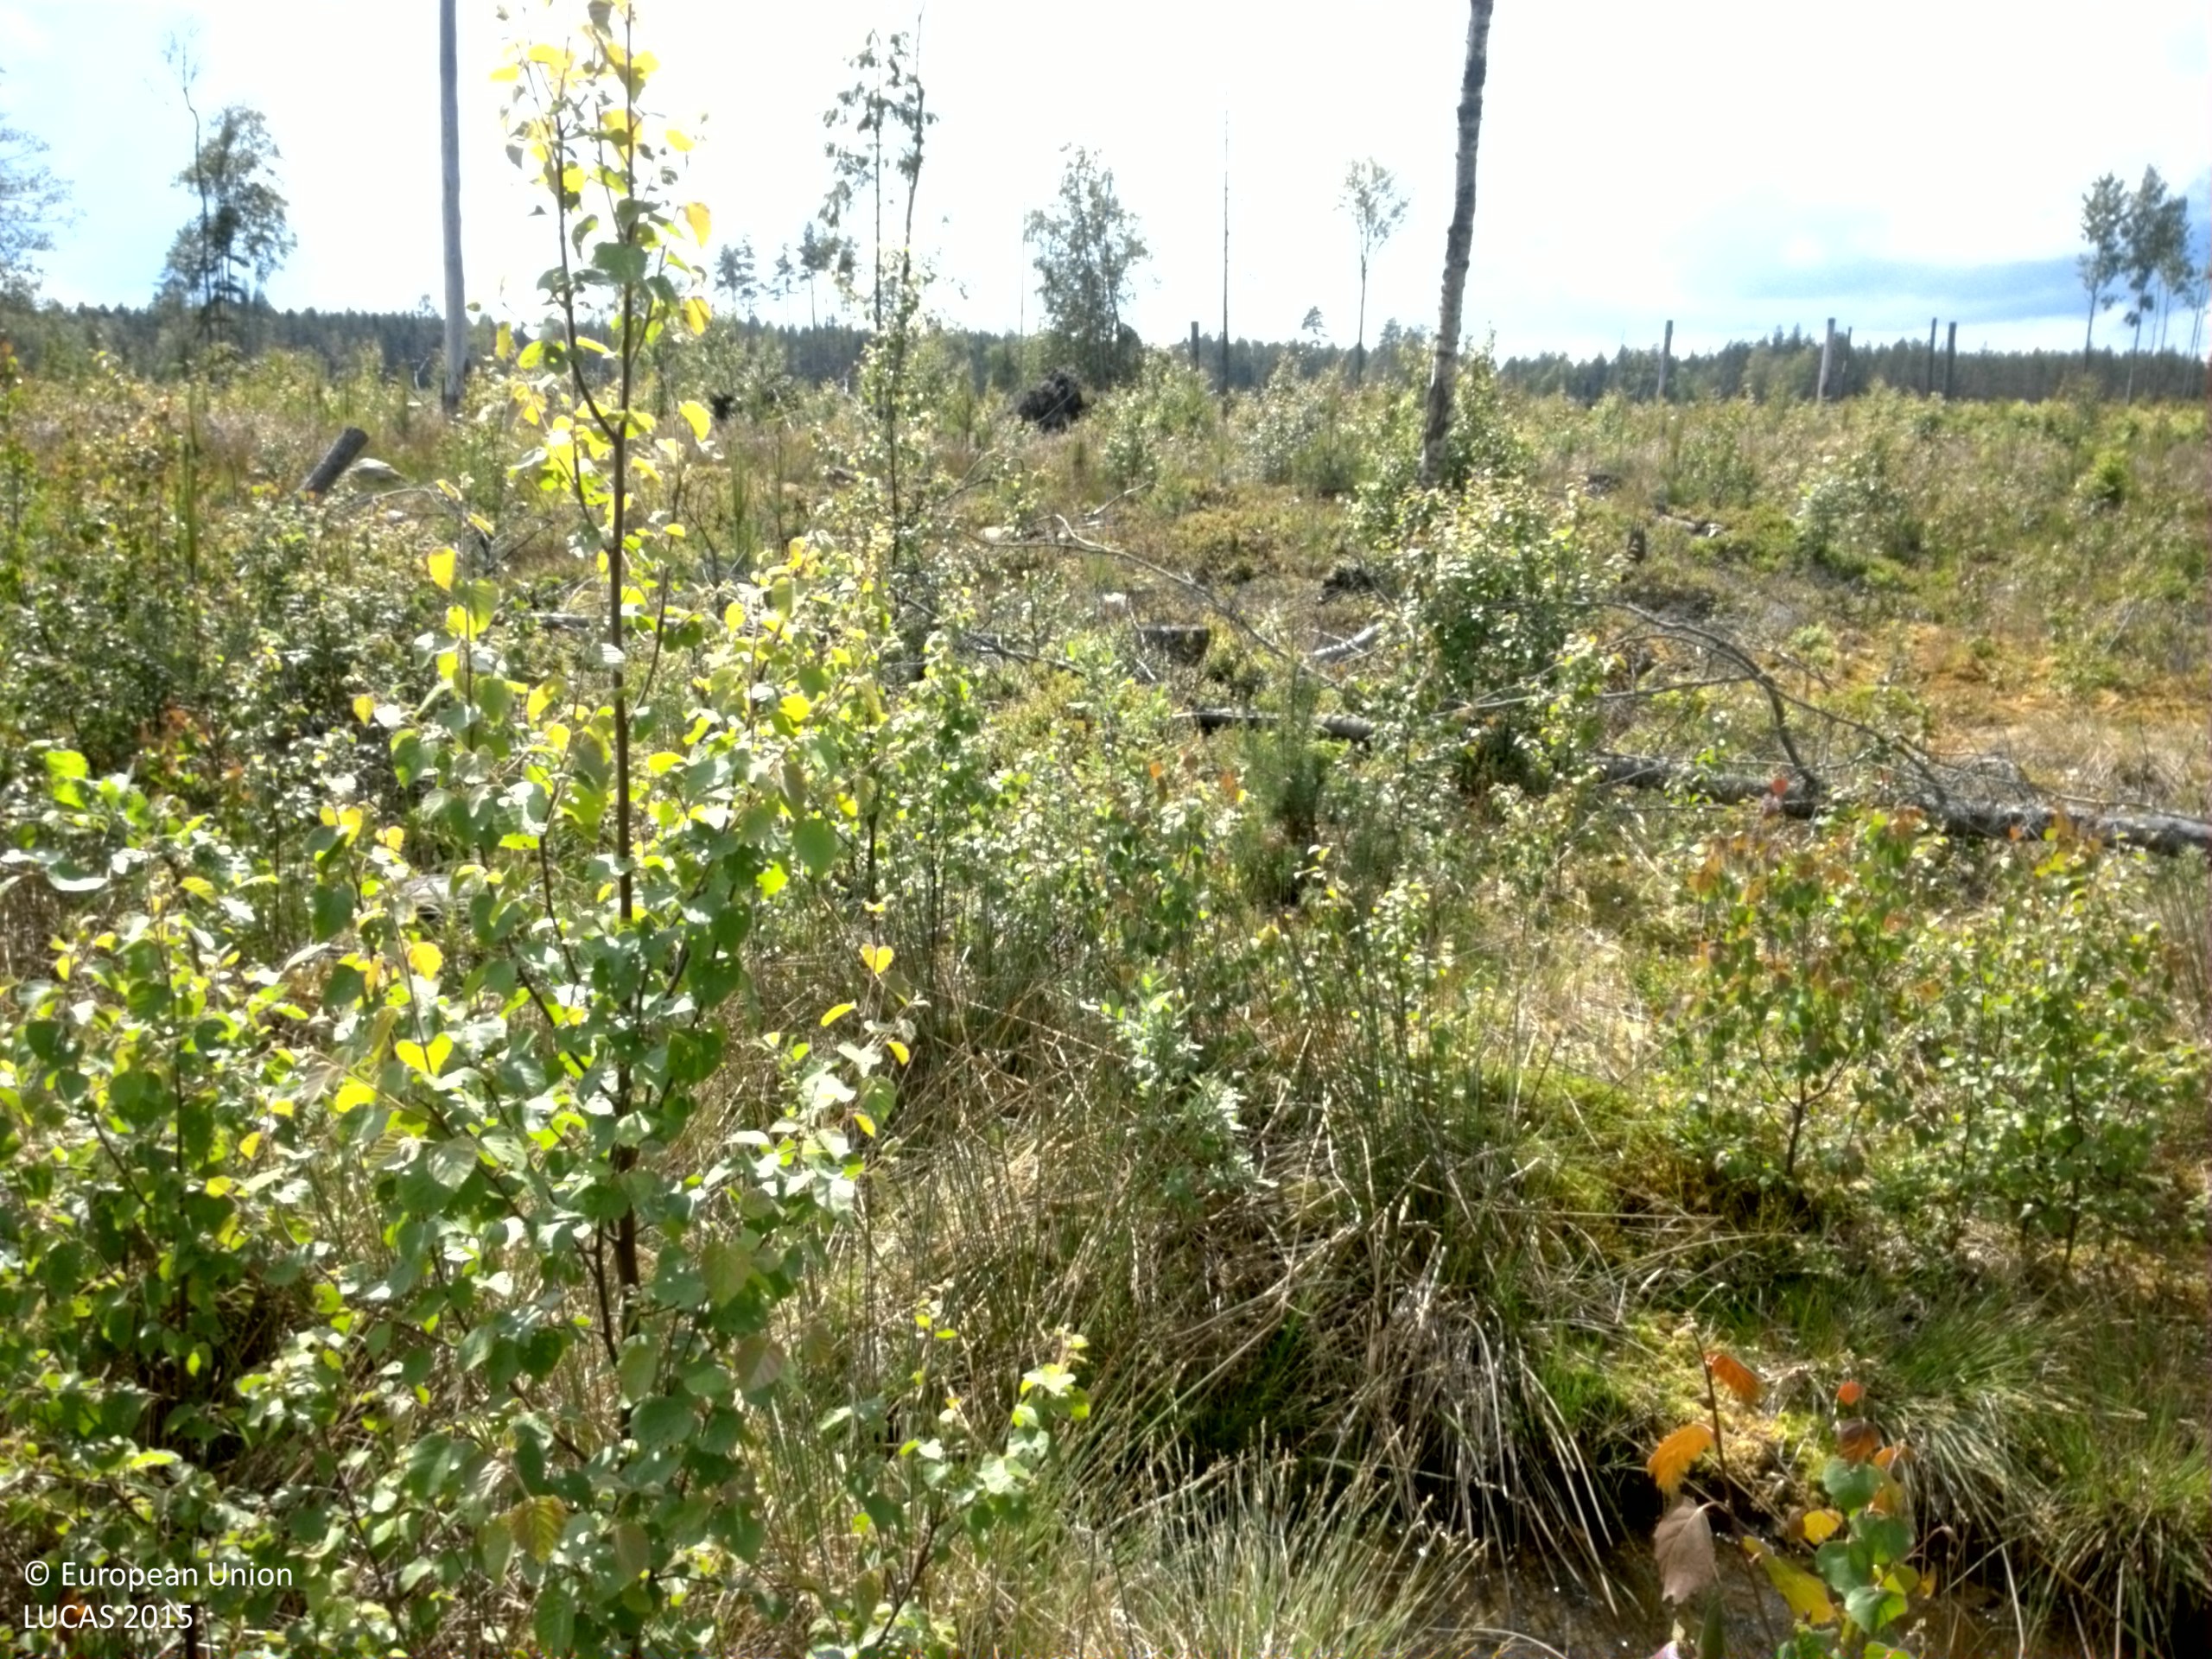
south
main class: Woodland
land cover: Broadleaved woodland
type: boreal forest
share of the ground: 25 - 50 %
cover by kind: herbaceous plants 45 %, broadleaved forest trees 35 %, lichens and mosses 10 %, coniferous forest trees 5 %, shrubs 5 %
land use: Forestry
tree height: < 5 m
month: June
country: SE
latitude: 60.4081
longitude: 17.6347
